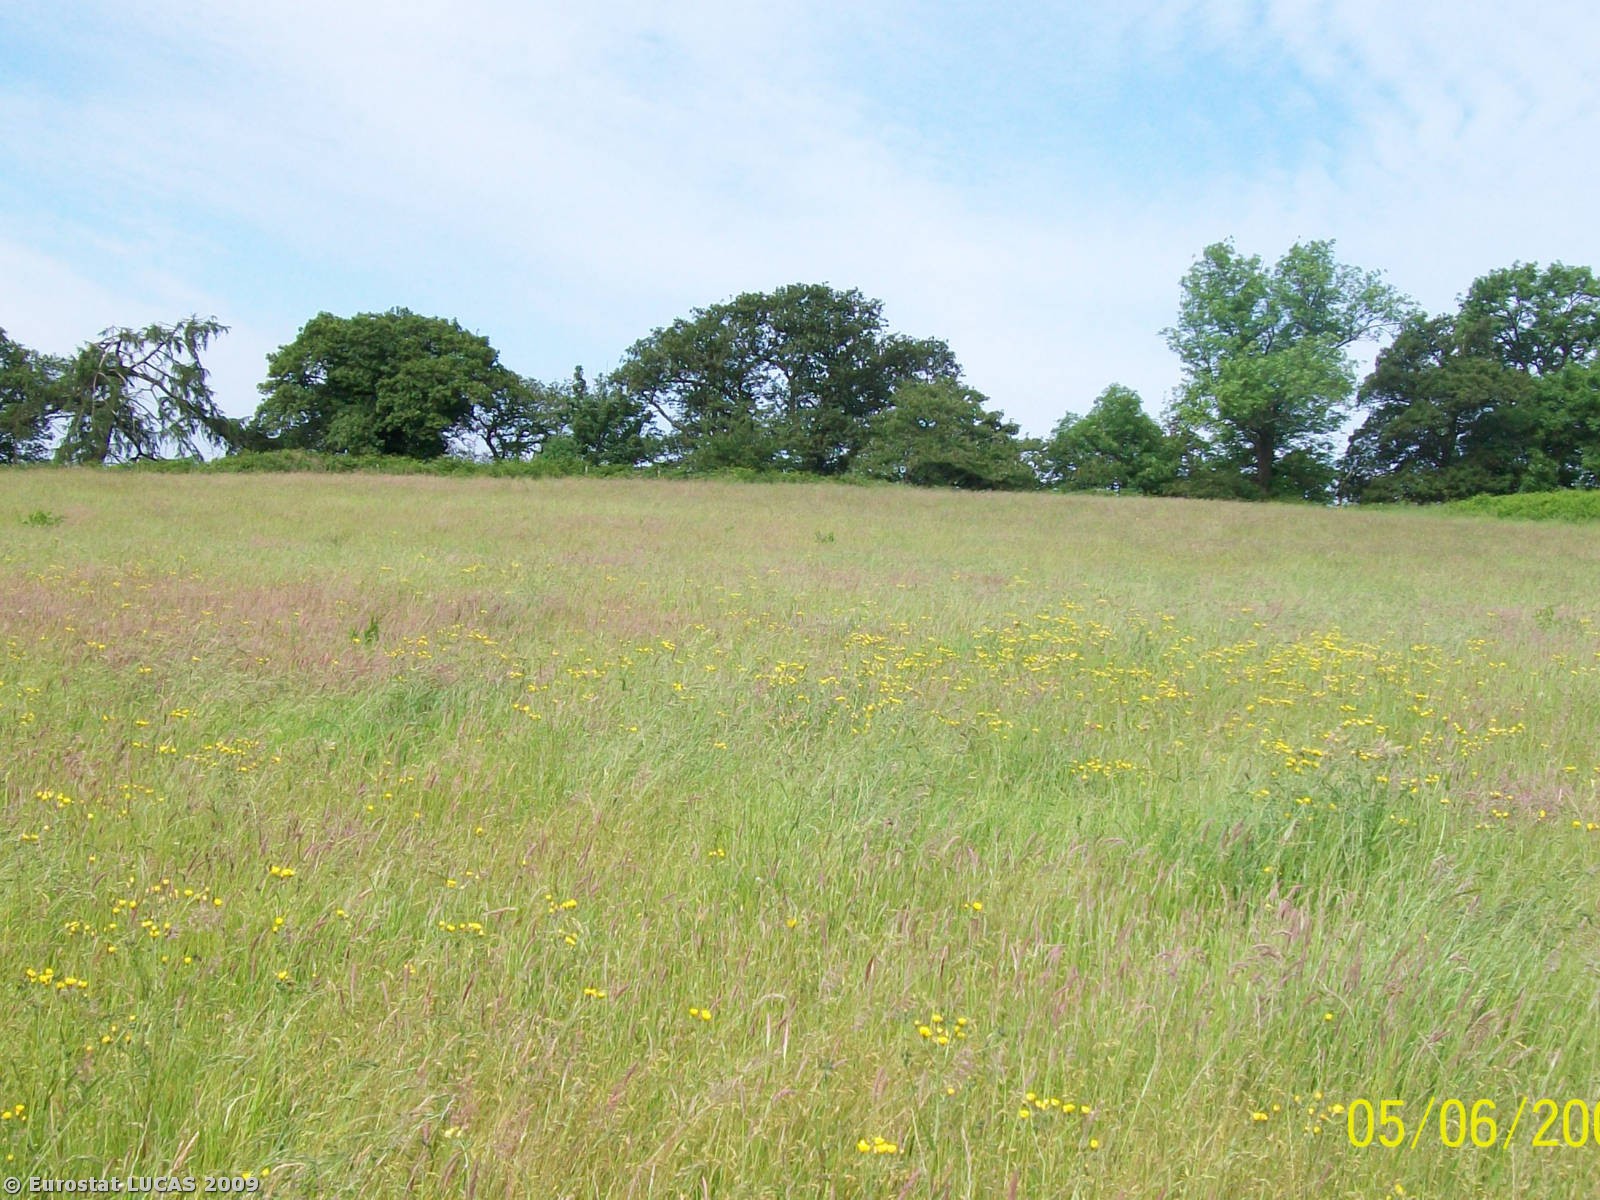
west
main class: Grassland
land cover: Grassland without tree/shrub cover
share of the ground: > 75 %
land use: Agriculture (excluding fallow land and kitchen gardens)
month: June
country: GB
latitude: 53.0682
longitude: -2.7710
